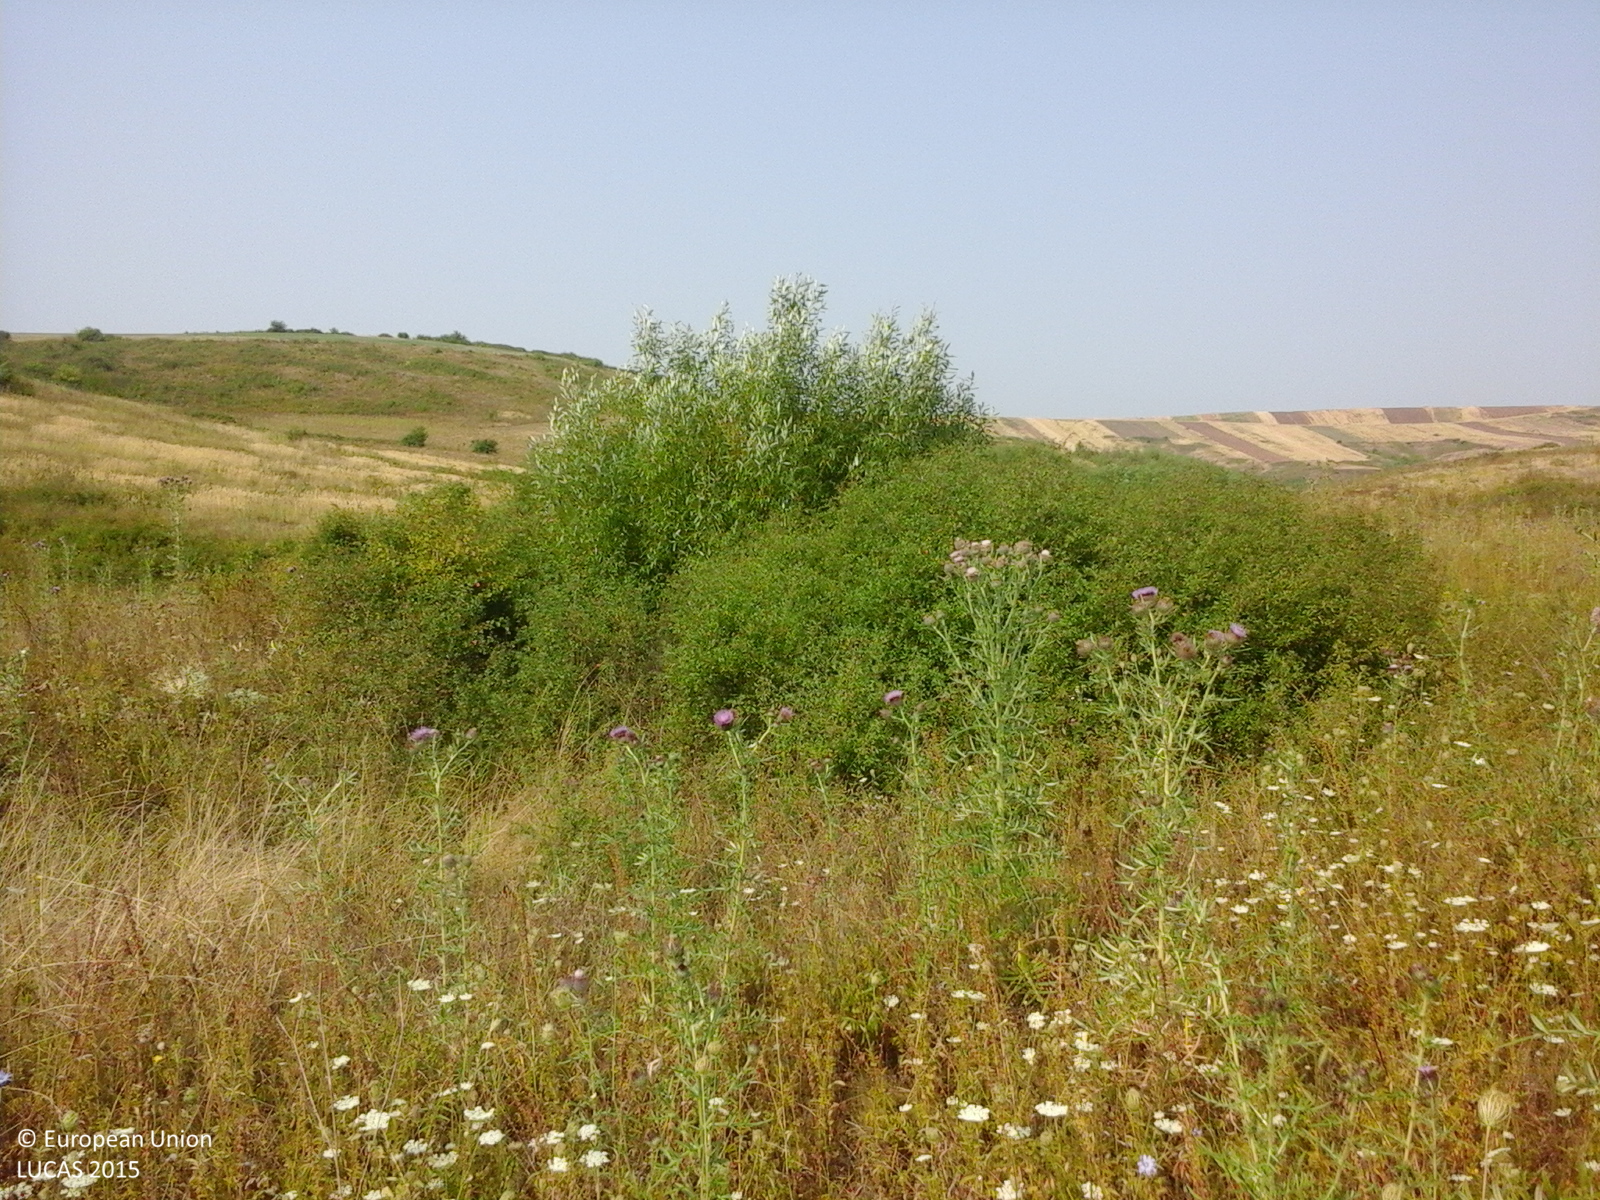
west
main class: Grassland
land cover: Spontaneously vegetated surfaces
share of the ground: > 75 %
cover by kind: herbaceous plants 100 %
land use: Fallow land
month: August
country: RO
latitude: 44.4824
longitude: 23.3916
